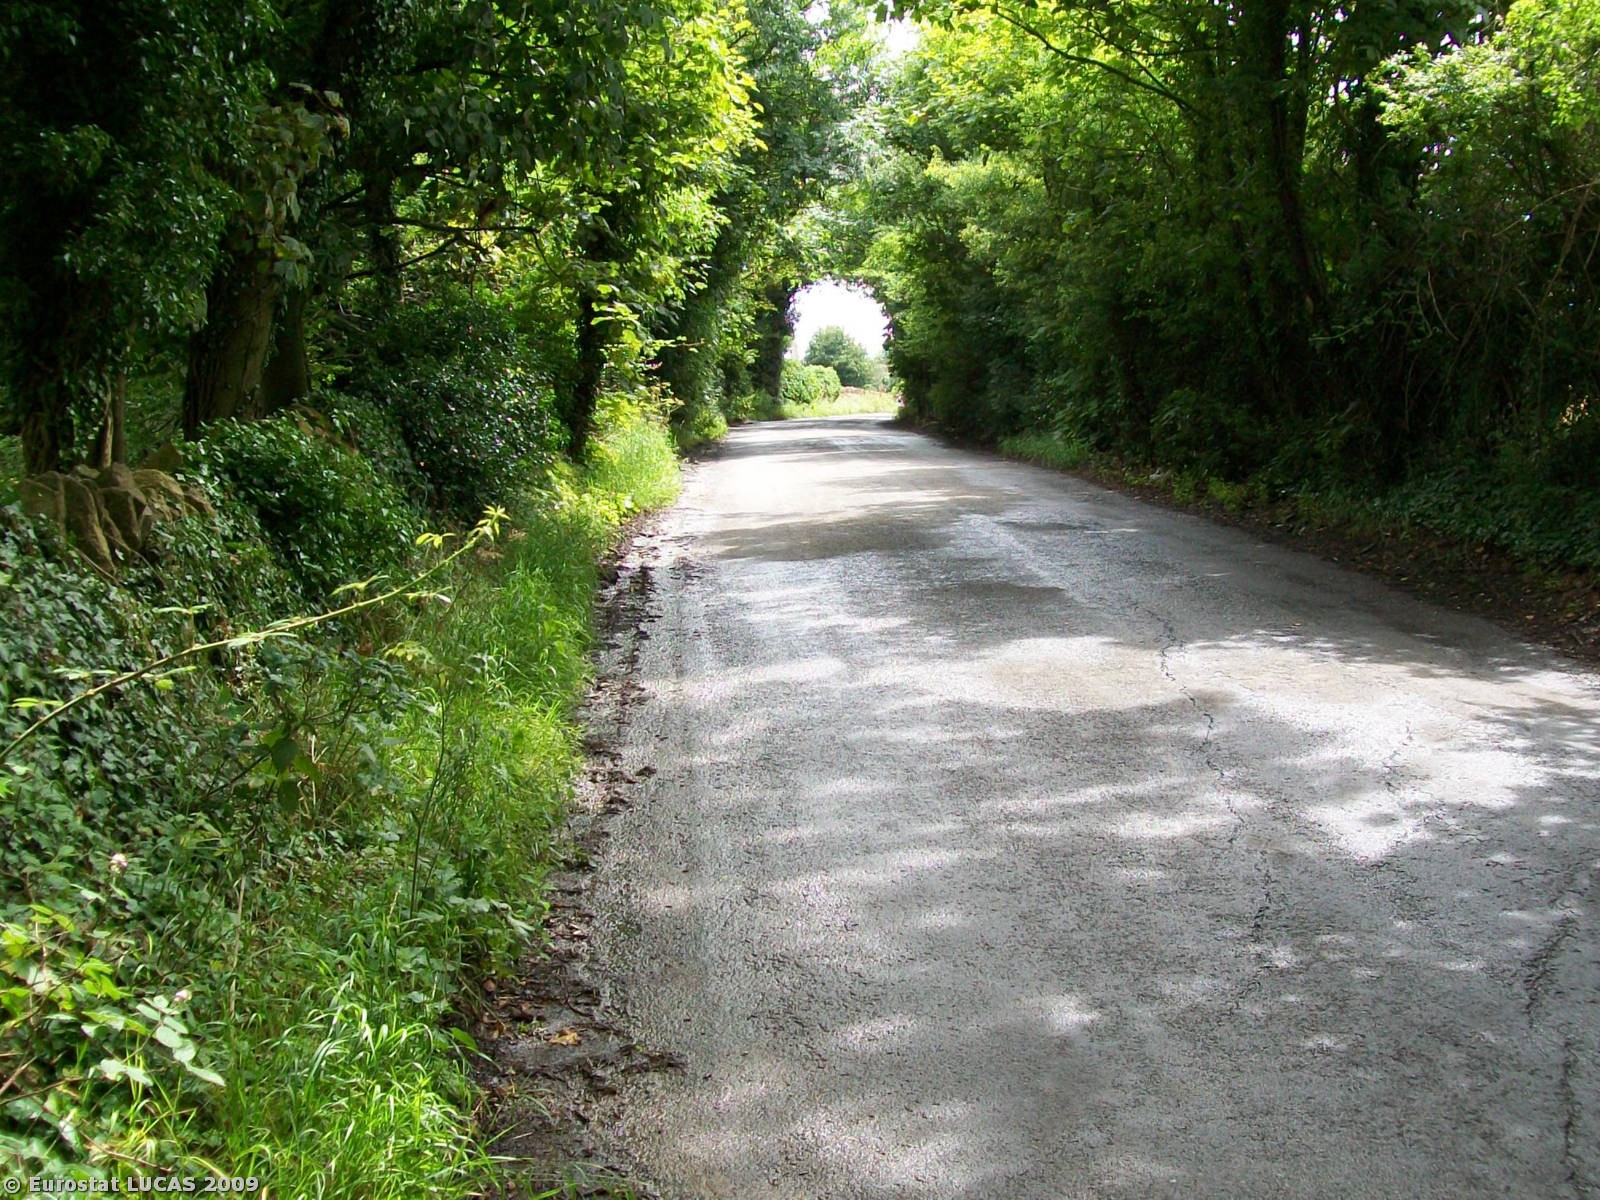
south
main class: Grassland
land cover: Grassland with sparse tree/shrub cover
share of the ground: > 75 %
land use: Agriculture (excluding fallow land and kitchen gardens)
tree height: > 5 m
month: July
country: GB
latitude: 51.4430
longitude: -2.3071
